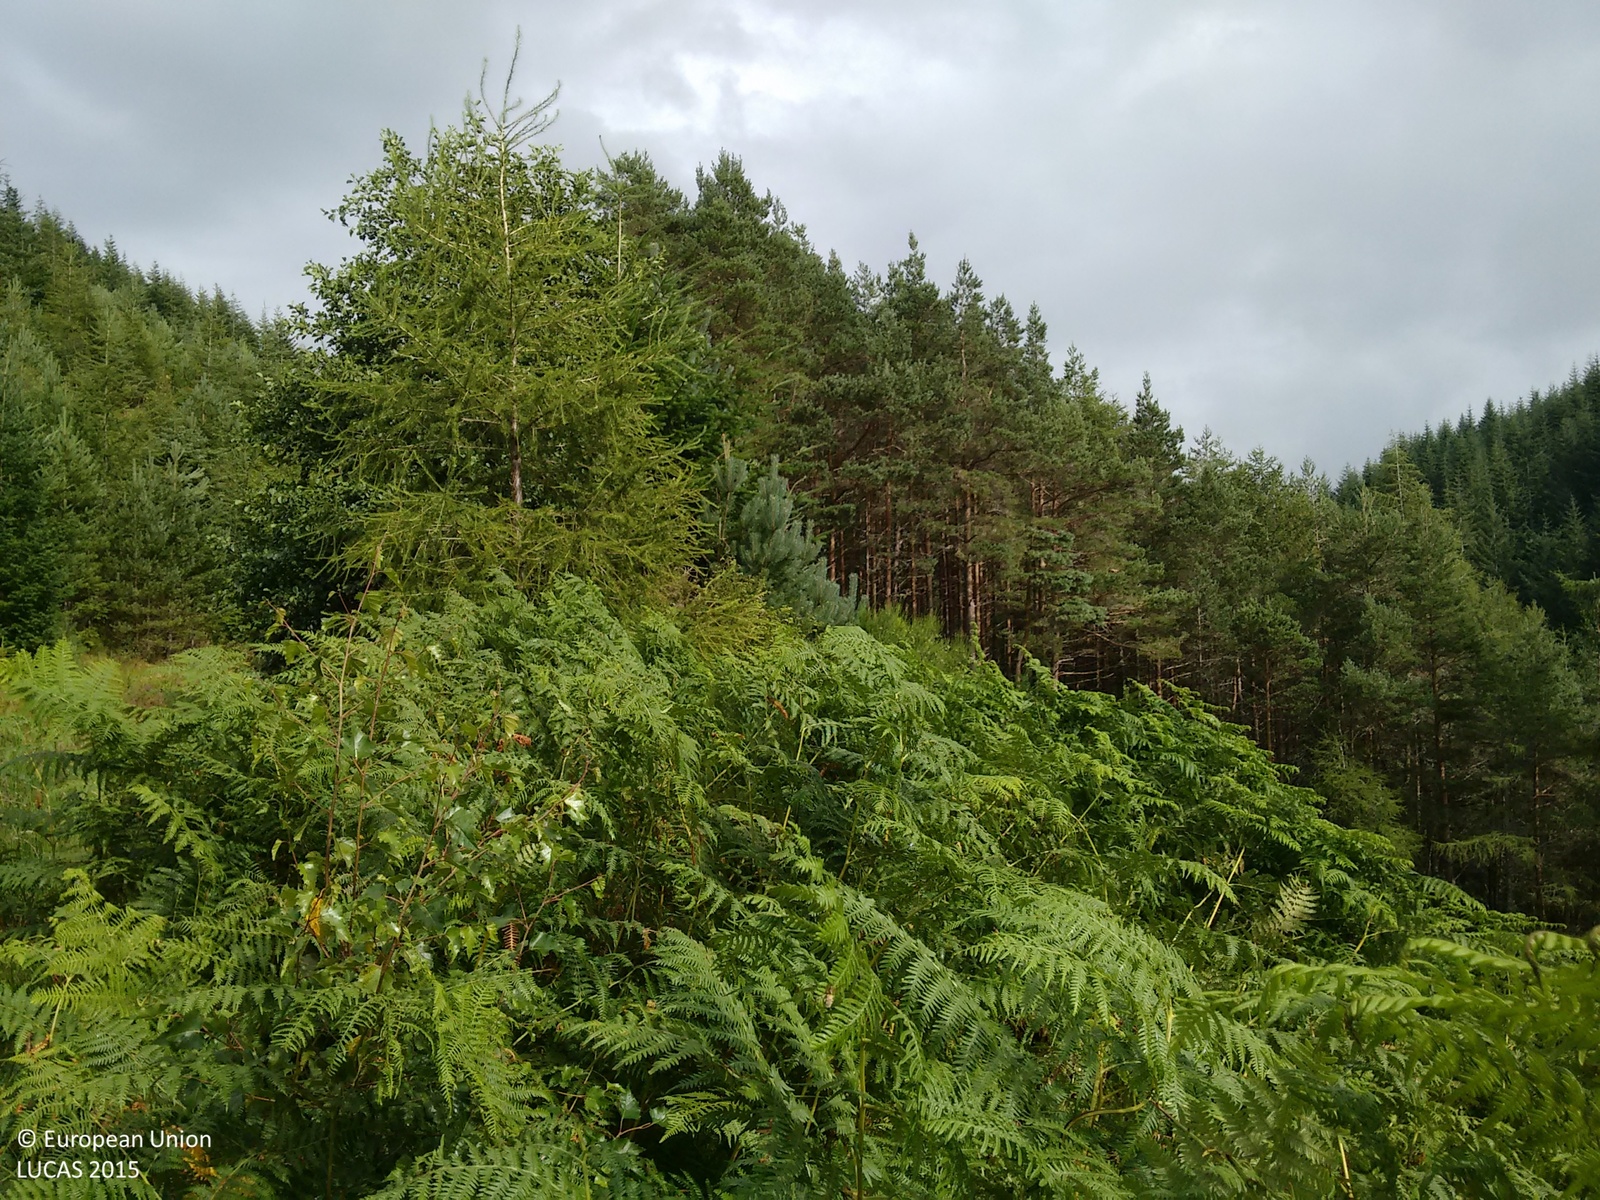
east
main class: Woodland
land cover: Other coniferous woodland
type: exotic forest
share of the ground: > 75 %
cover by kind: coniferous forest trees 100 %
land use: Forestry
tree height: > 5 m
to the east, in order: Other coniferous woodland
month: August
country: GB
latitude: 57.3149
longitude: -4.5207
